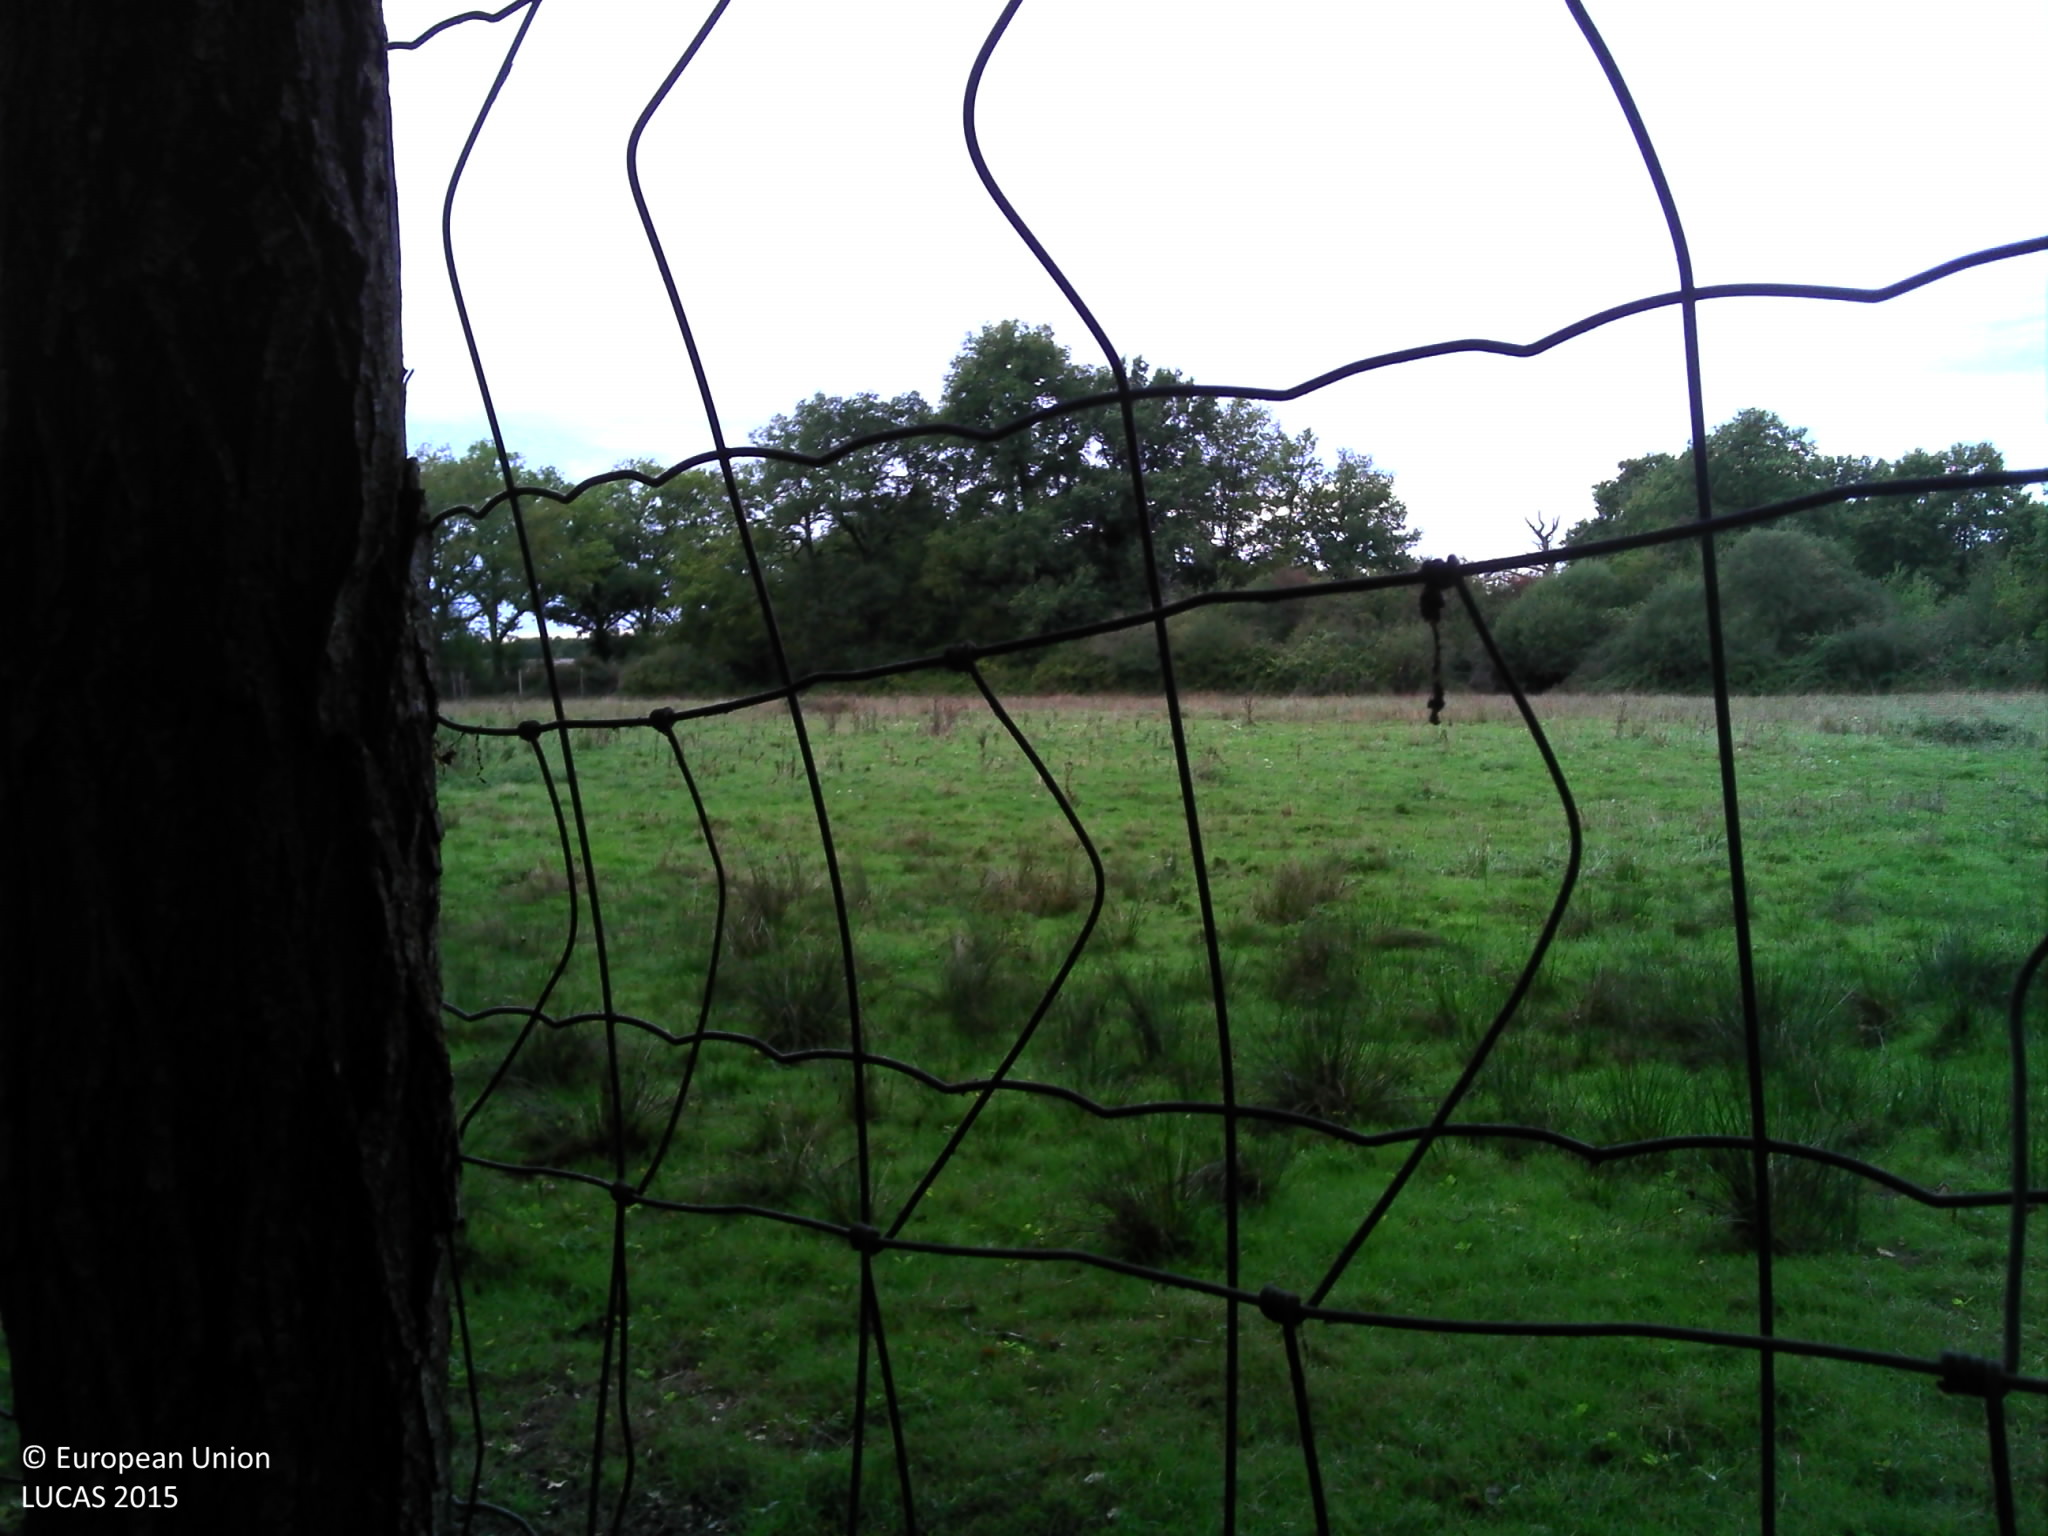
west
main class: Grassland
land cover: Grassland without tree/shrub cover
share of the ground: > 75 %
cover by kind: herbaceous plants 100 %
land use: Agriculture (excluding fallow land and kitchen gardens)
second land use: Amenities, museums, leisure
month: September
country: FR
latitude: 46.4924
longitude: 1.1673
